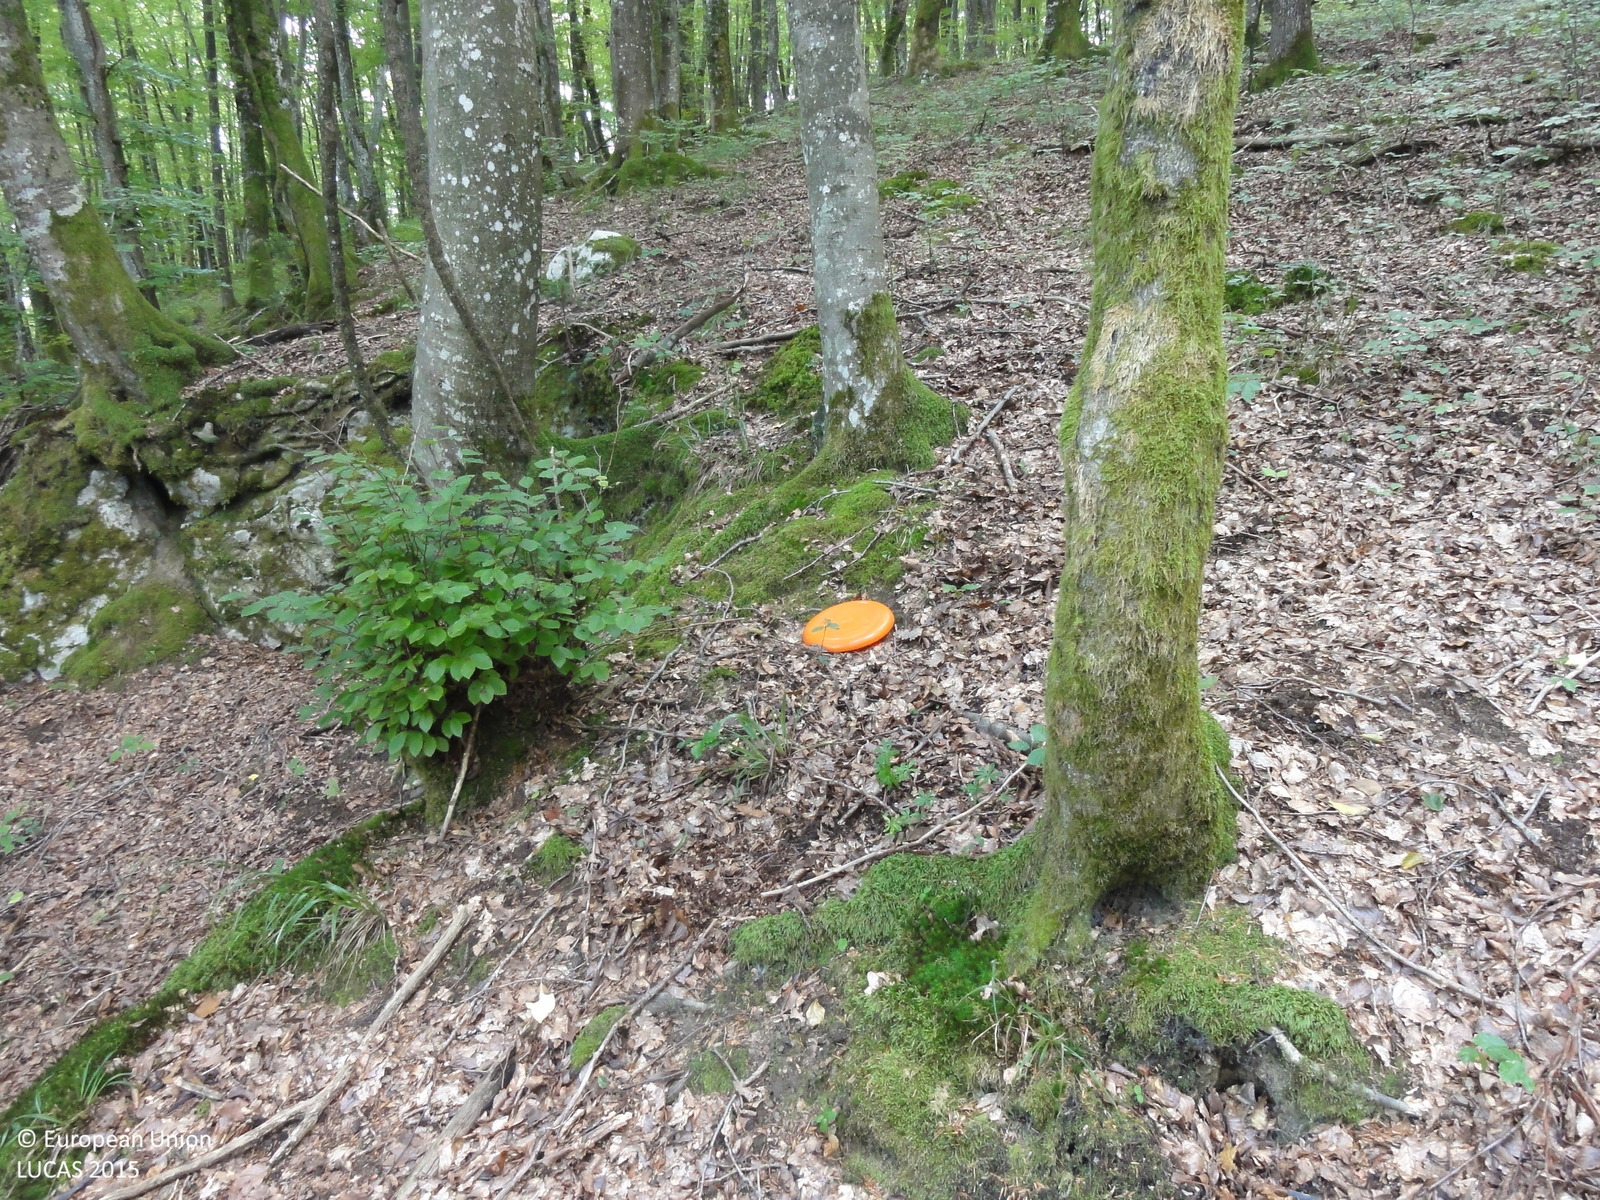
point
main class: Woodland
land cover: Broadleaved woodland
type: beech forest
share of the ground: > 75 %
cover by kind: broadleaved forest trees 100 %
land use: Forestry
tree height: > 5 m
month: September
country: SI
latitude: 45.9040
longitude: 15.1141
